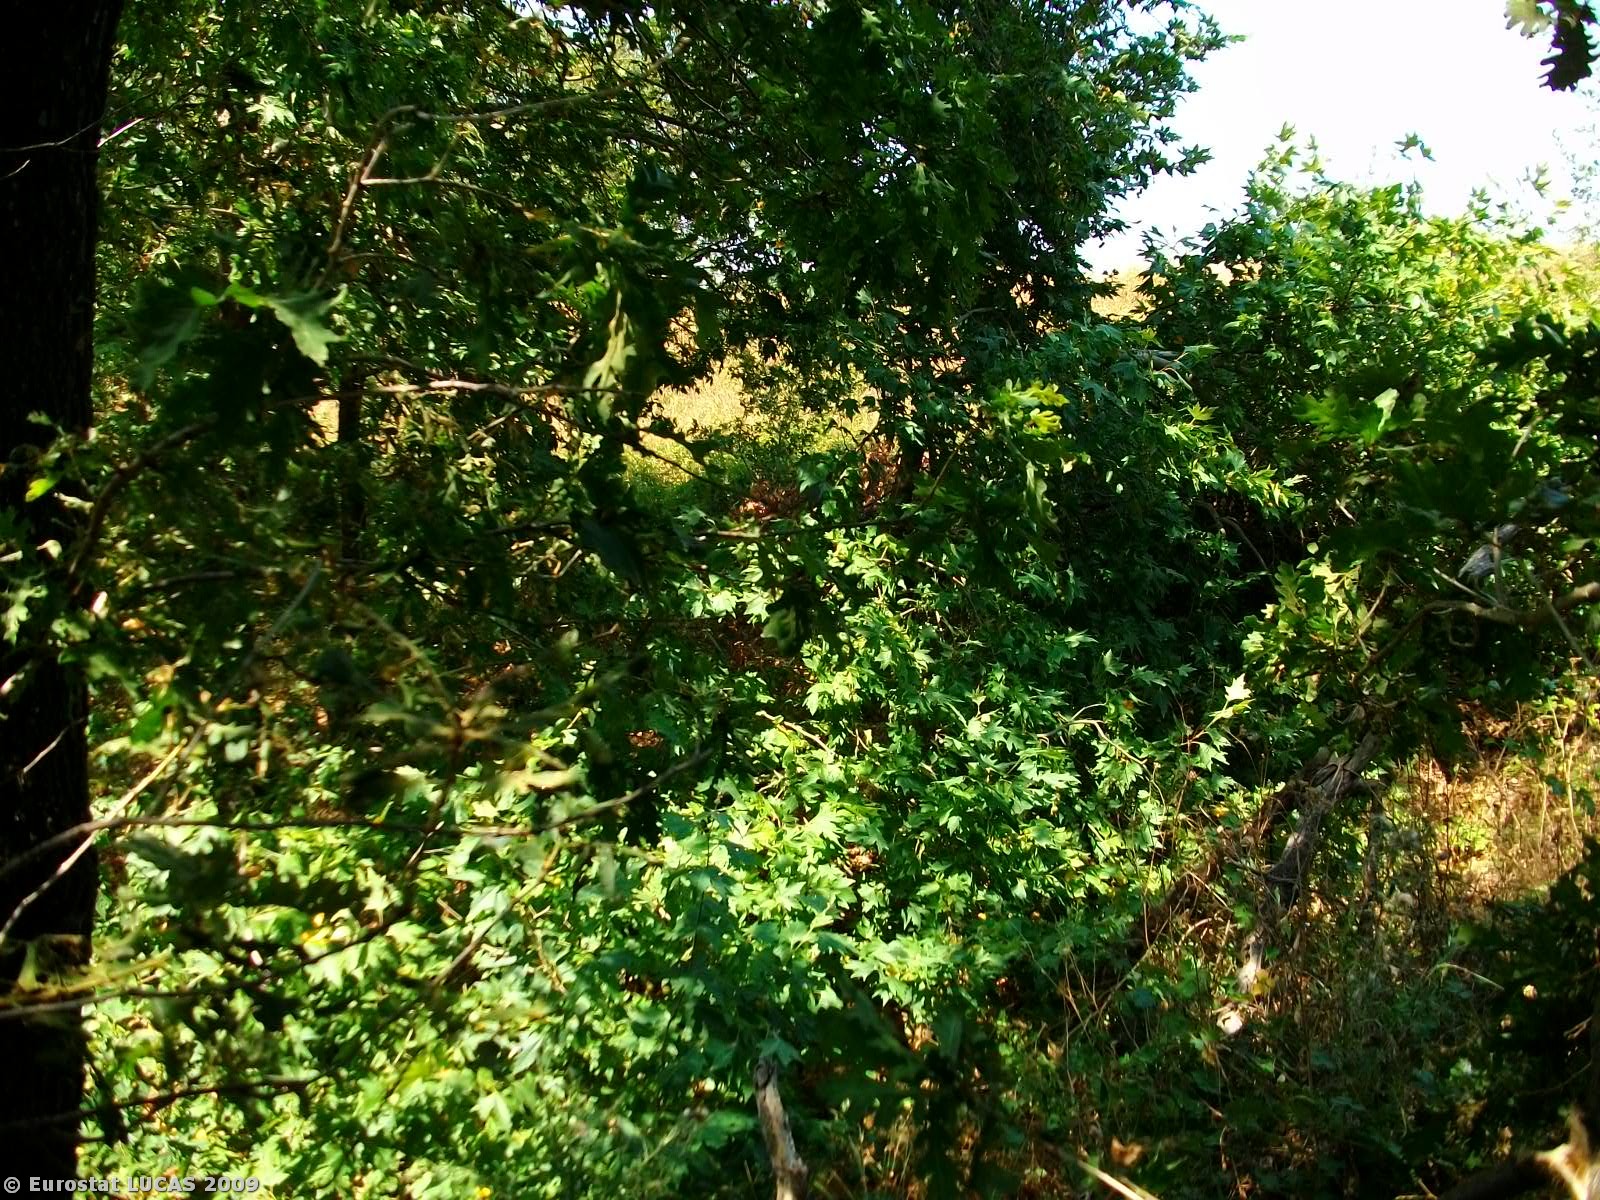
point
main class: Woodland
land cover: Broadleaved woodland
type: broadleaved evergreen forest
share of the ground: > 75 %
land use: Forestry
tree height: > 5 m
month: August
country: GR
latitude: 38.6812
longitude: 22.4736
